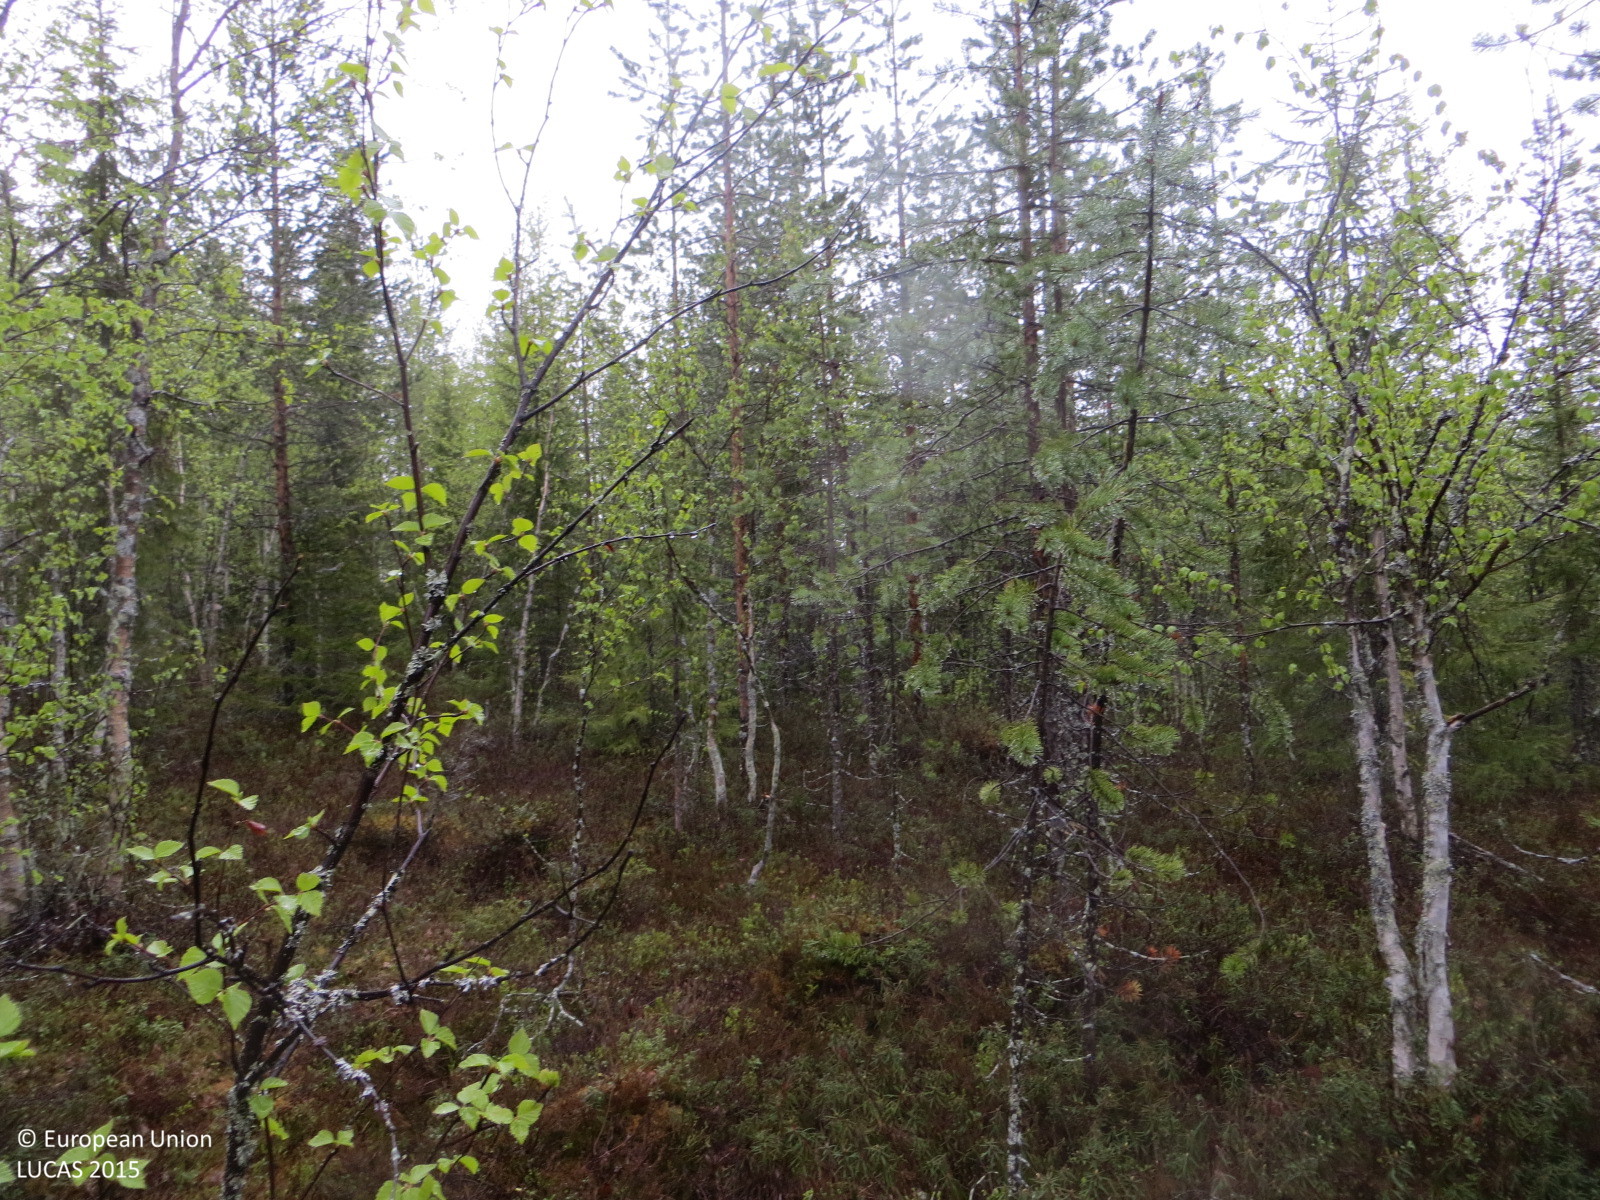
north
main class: Woodland
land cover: Other mixed woodland
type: boreal forest
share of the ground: > 75 %
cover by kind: coniferous forest trees 50 %, broadleaved forest trees 30 %, shrubs 20 %
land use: Forestry
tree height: > 5 m
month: June
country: FI
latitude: 66.8779
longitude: 25.4147
